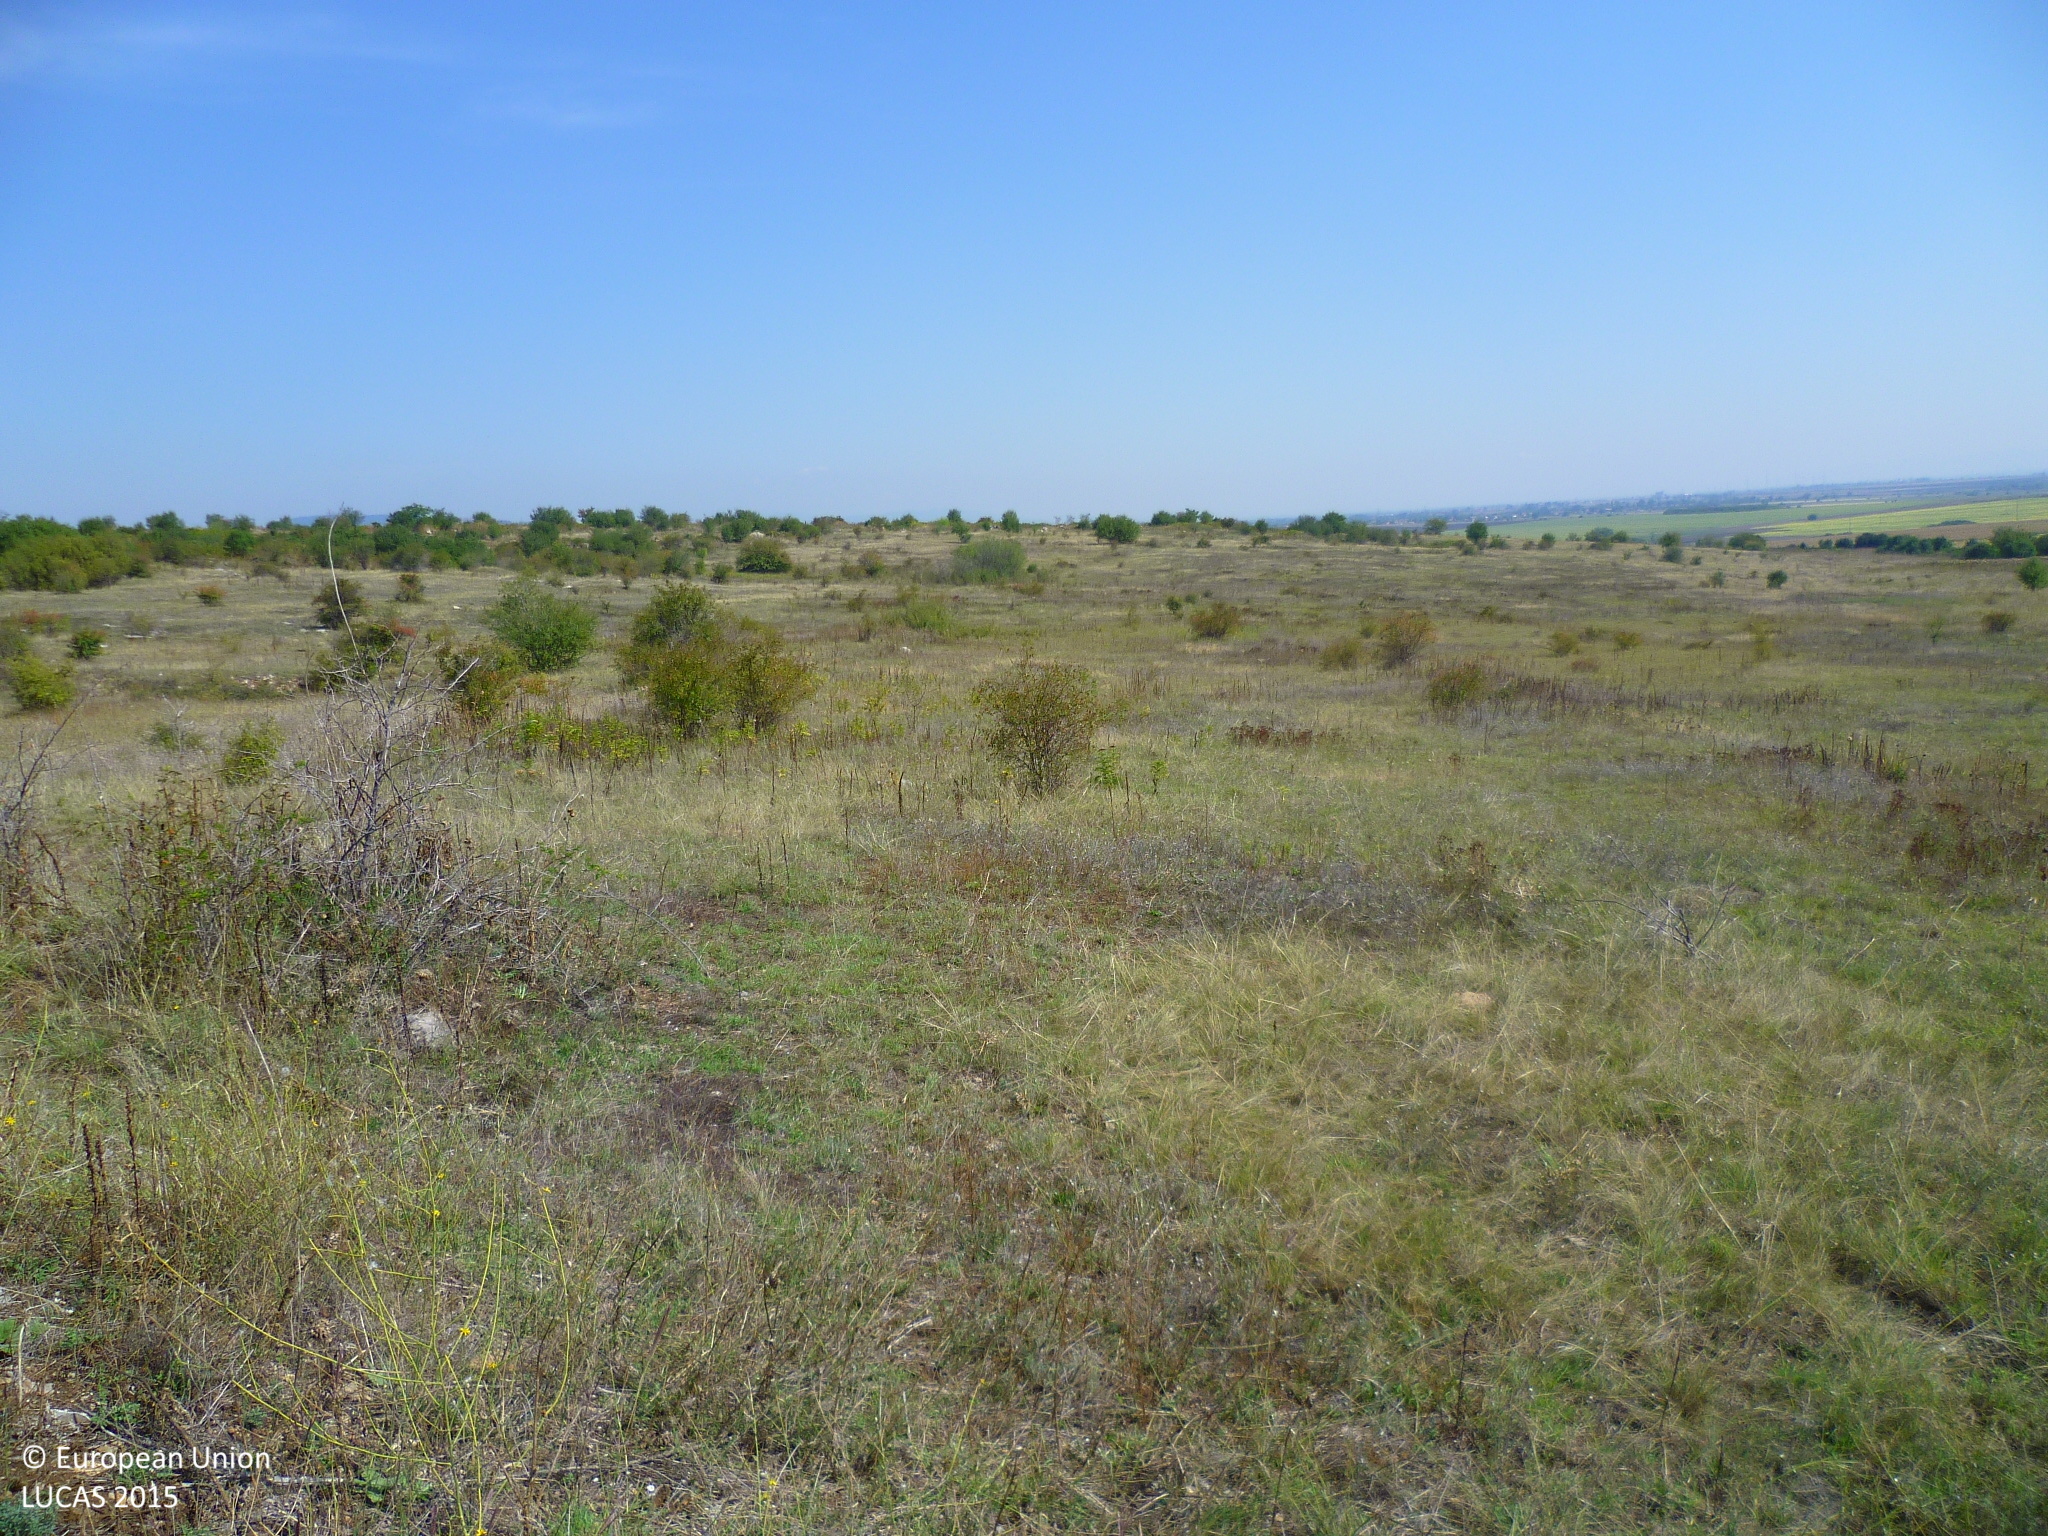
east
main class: Grassland
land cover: Grassland with sparse tree/shrub cover
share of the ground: > 75 %
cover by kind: herbaceous plants 90 %, broadleaved forest trees 5 %, shrubs 5 %
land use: Agriculture (excluding fallow land and kitchen gardens)
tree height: < 5 m
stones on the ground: 10 - 25 %
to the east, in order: Grassland with sparse tree/shrub cover; Shrubland without tree cover; Grassland with sparse tree/shrub cover
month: September
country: BG
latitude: 42.8598
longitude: 23.0915
